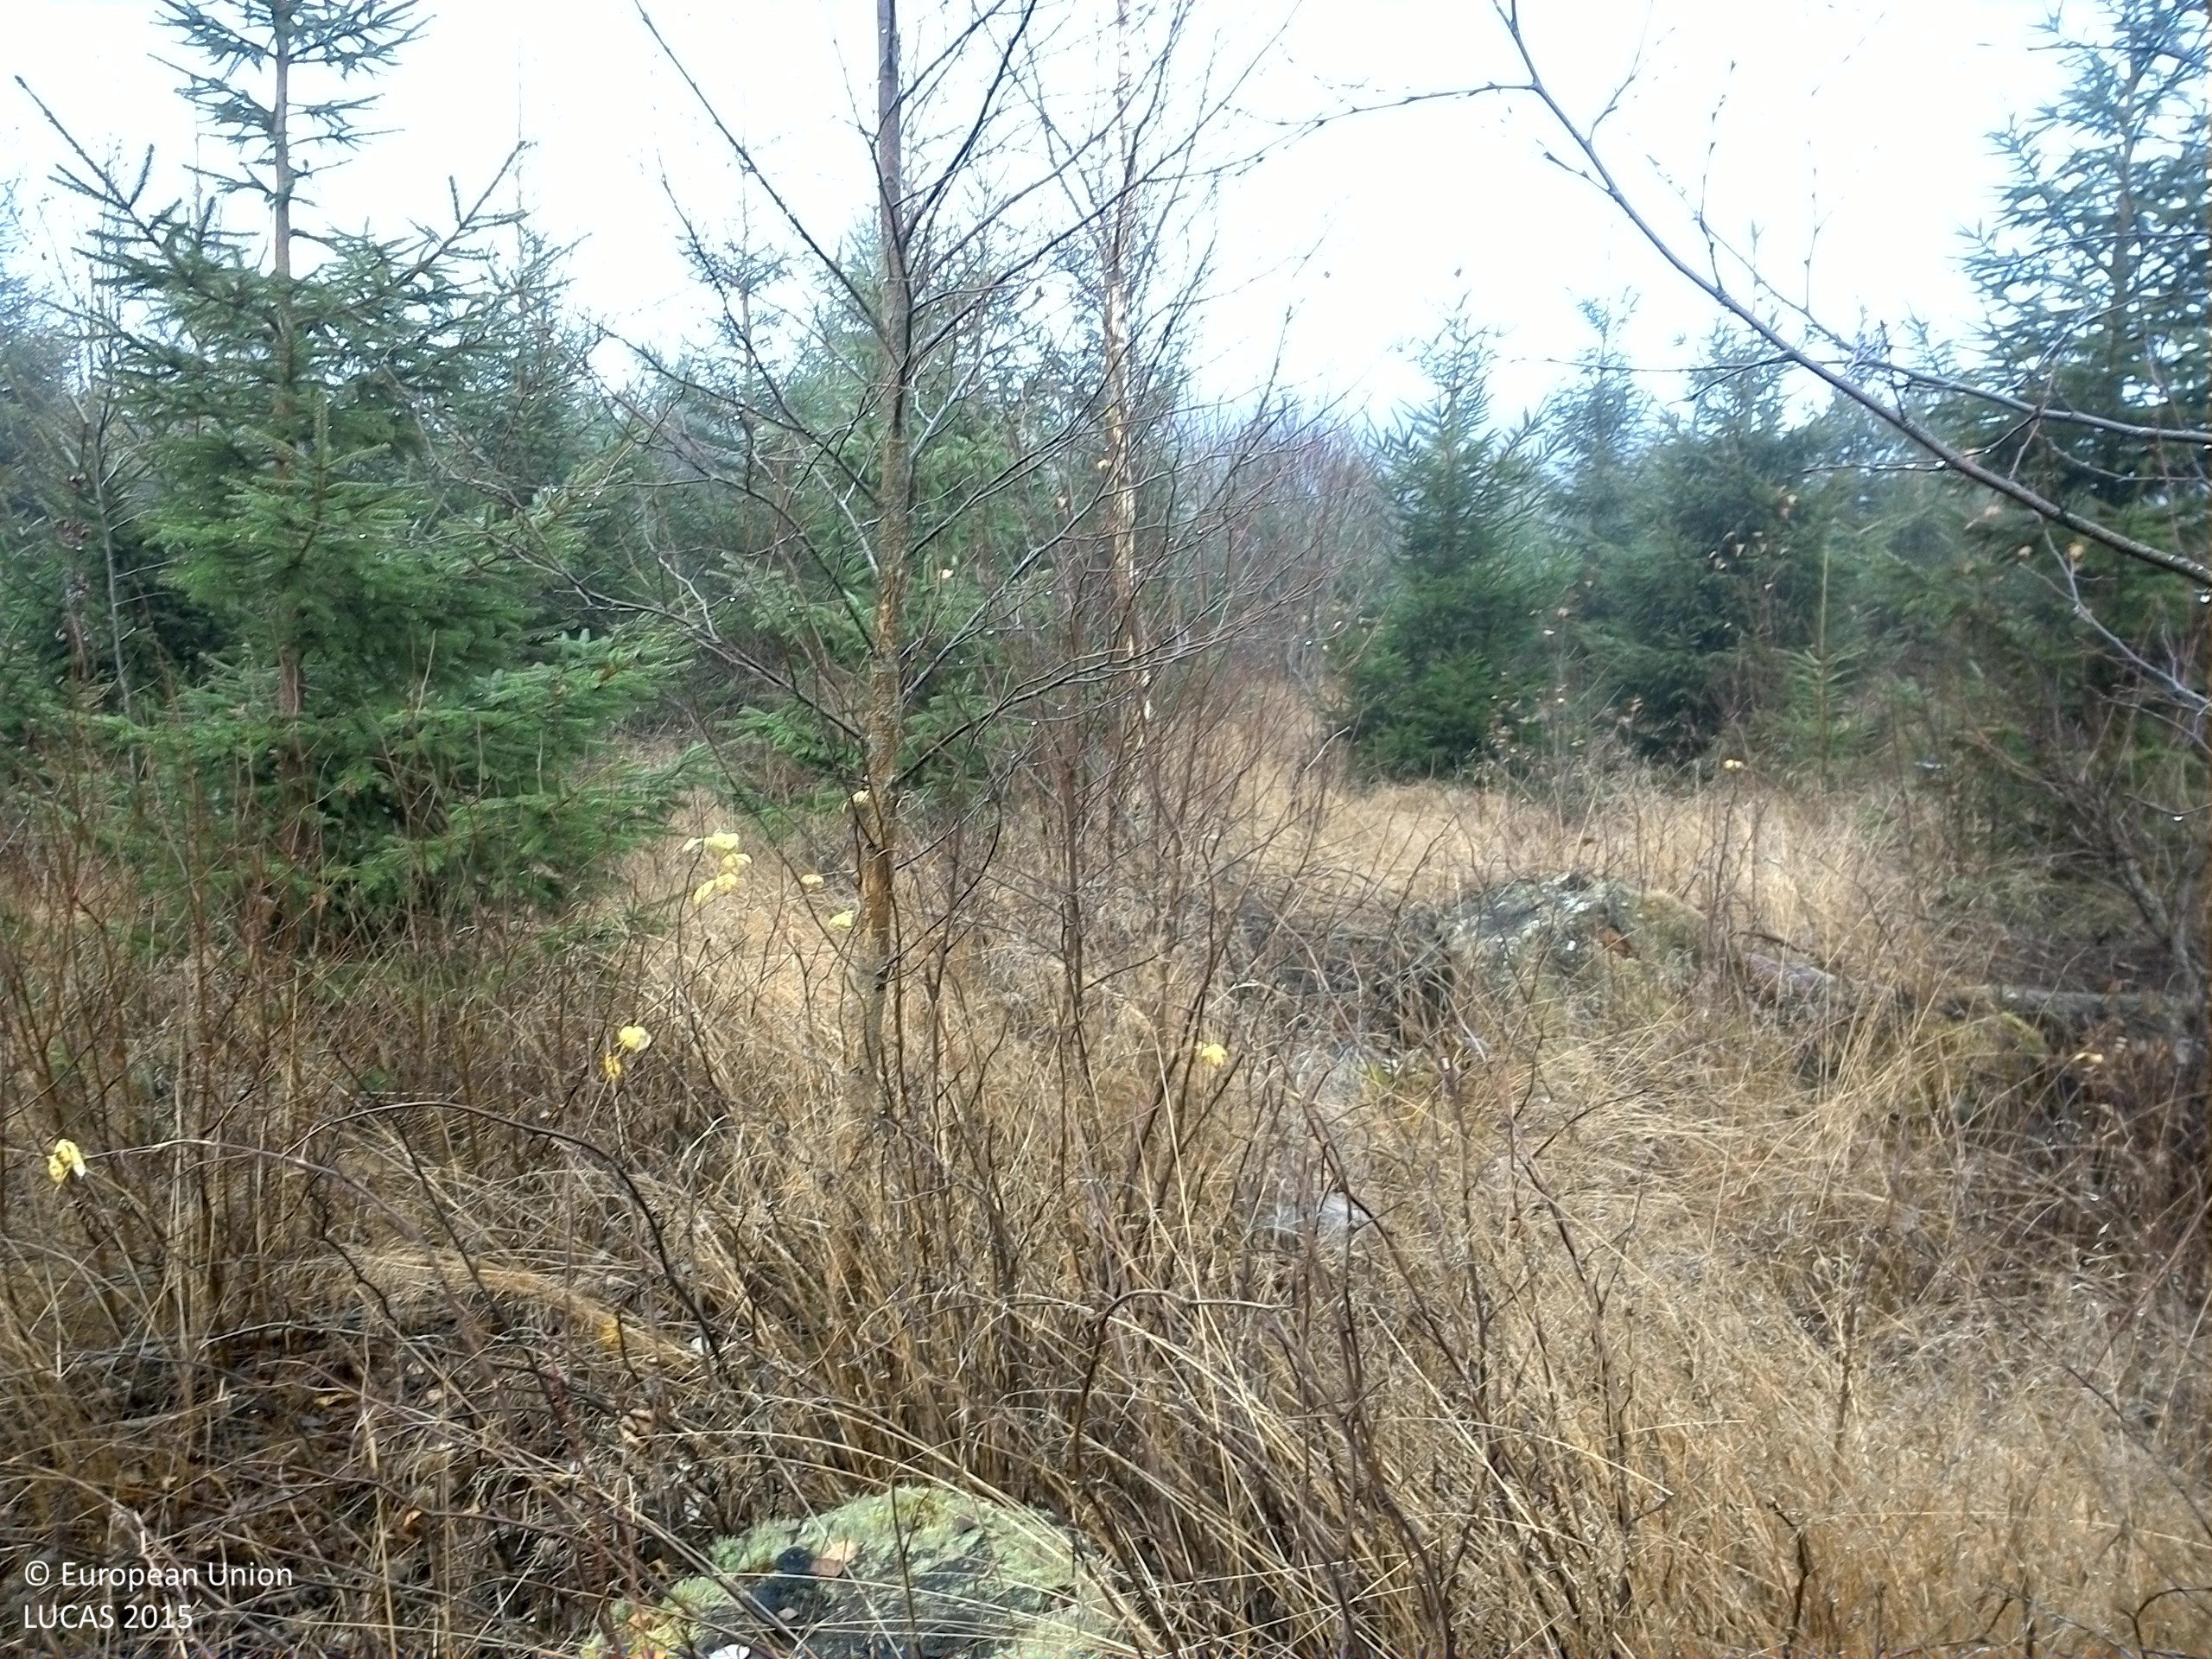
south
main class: Woodland
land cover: Spruce dominated mixed woodland
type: boreal forest
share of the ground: 50 - 75 %
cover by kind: coniferous forest trees 45 %, broadleaved forest trees 25 %, shrubs 15 %, herbaceous plants 15 %
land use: Forestry
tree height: < 5 m
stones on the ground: < 10 %
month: November
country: SE
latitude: 57.9150
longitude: 14.8731
